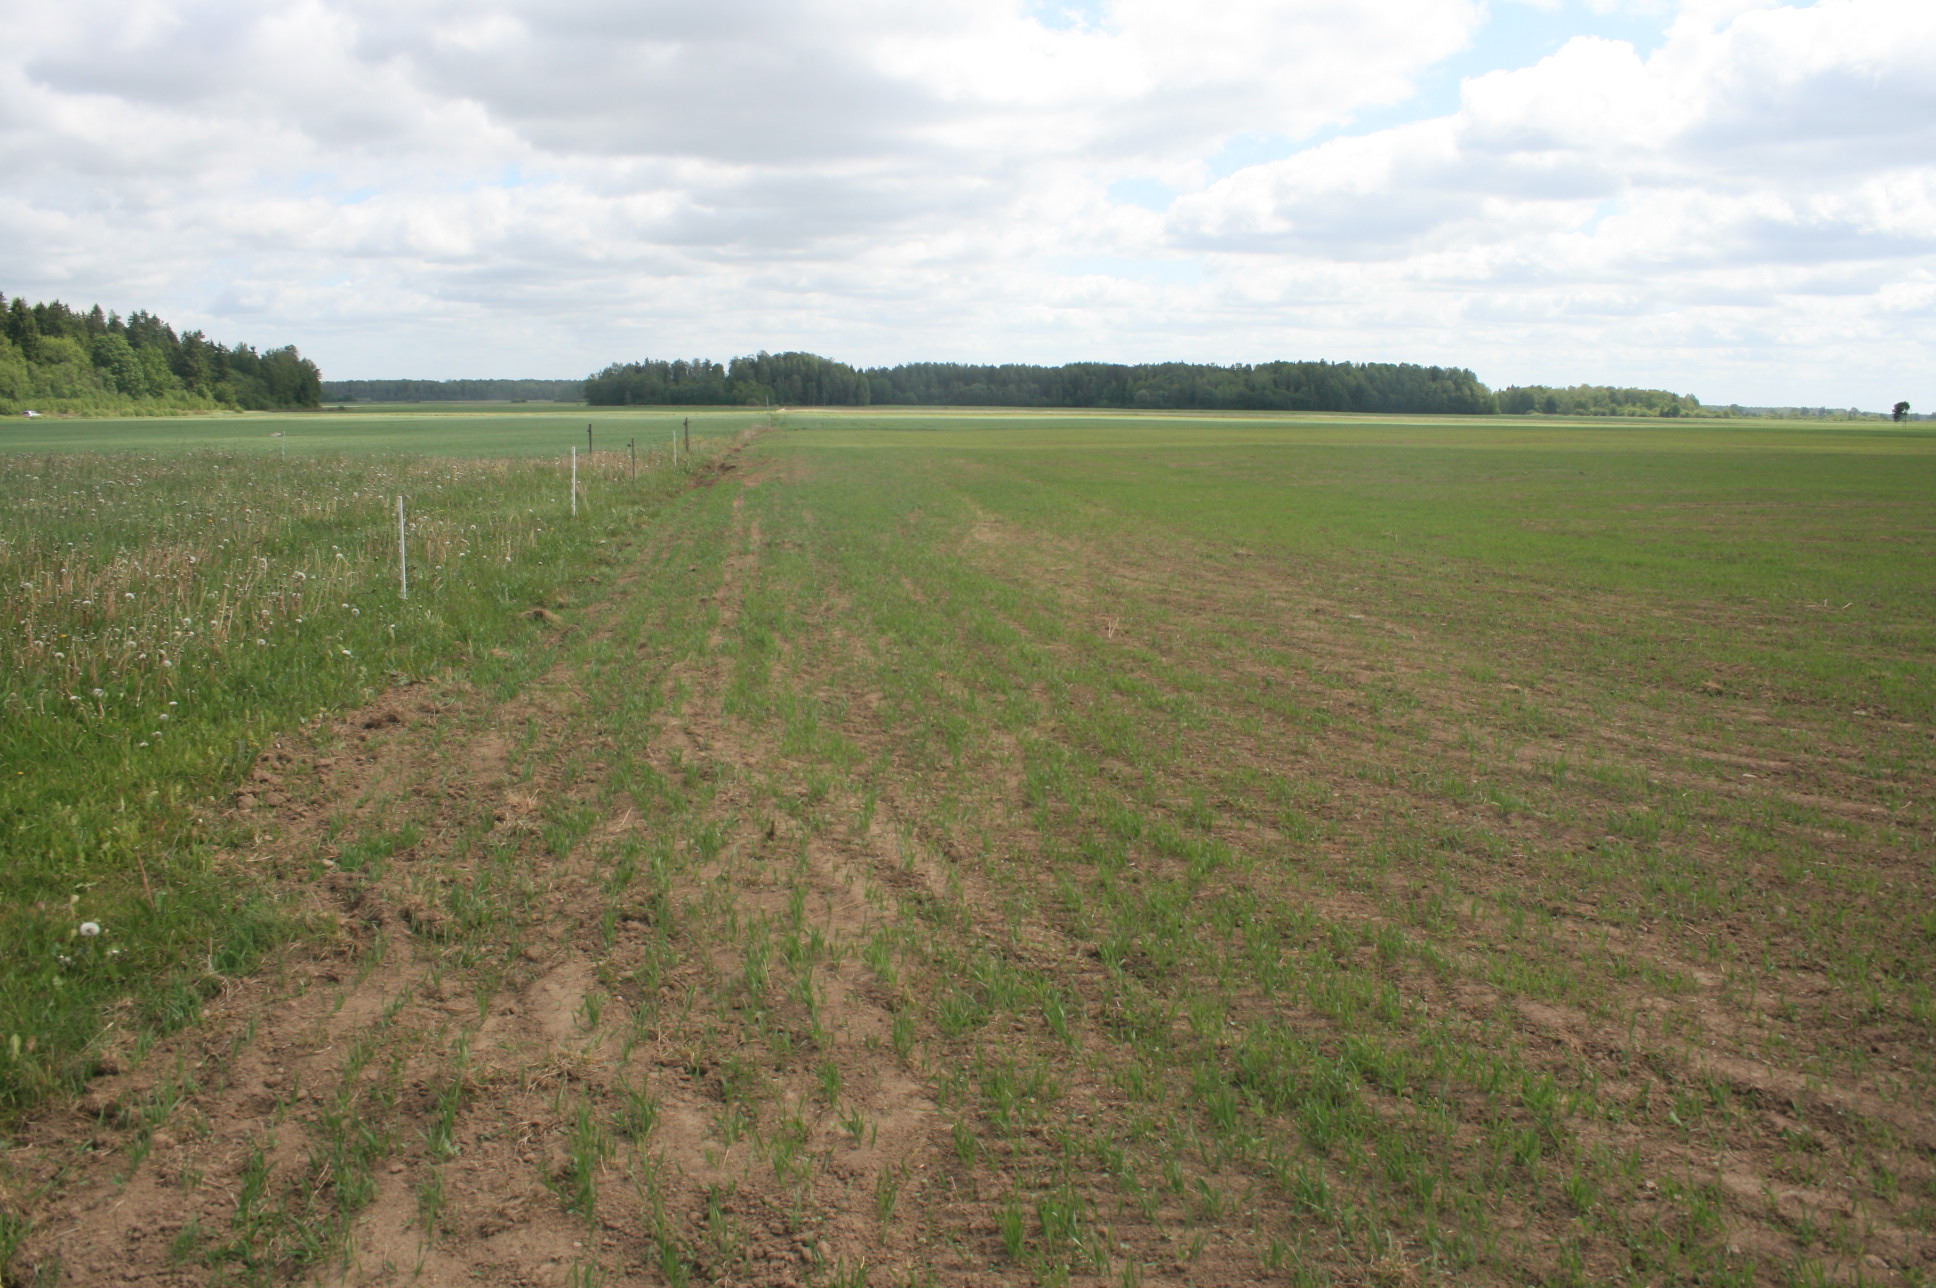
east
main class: Cropland
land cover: Other leguminous and mixtures for fodder
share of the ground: < 10 %
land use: Agriculture (excluding fallow land and kitchen gardens)
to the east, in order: Other leguminous and mixtures for fodder; Grassland without tree/shrub cover; Common wheat
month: June
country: LT
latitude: 56.1893
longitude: 22.3508
